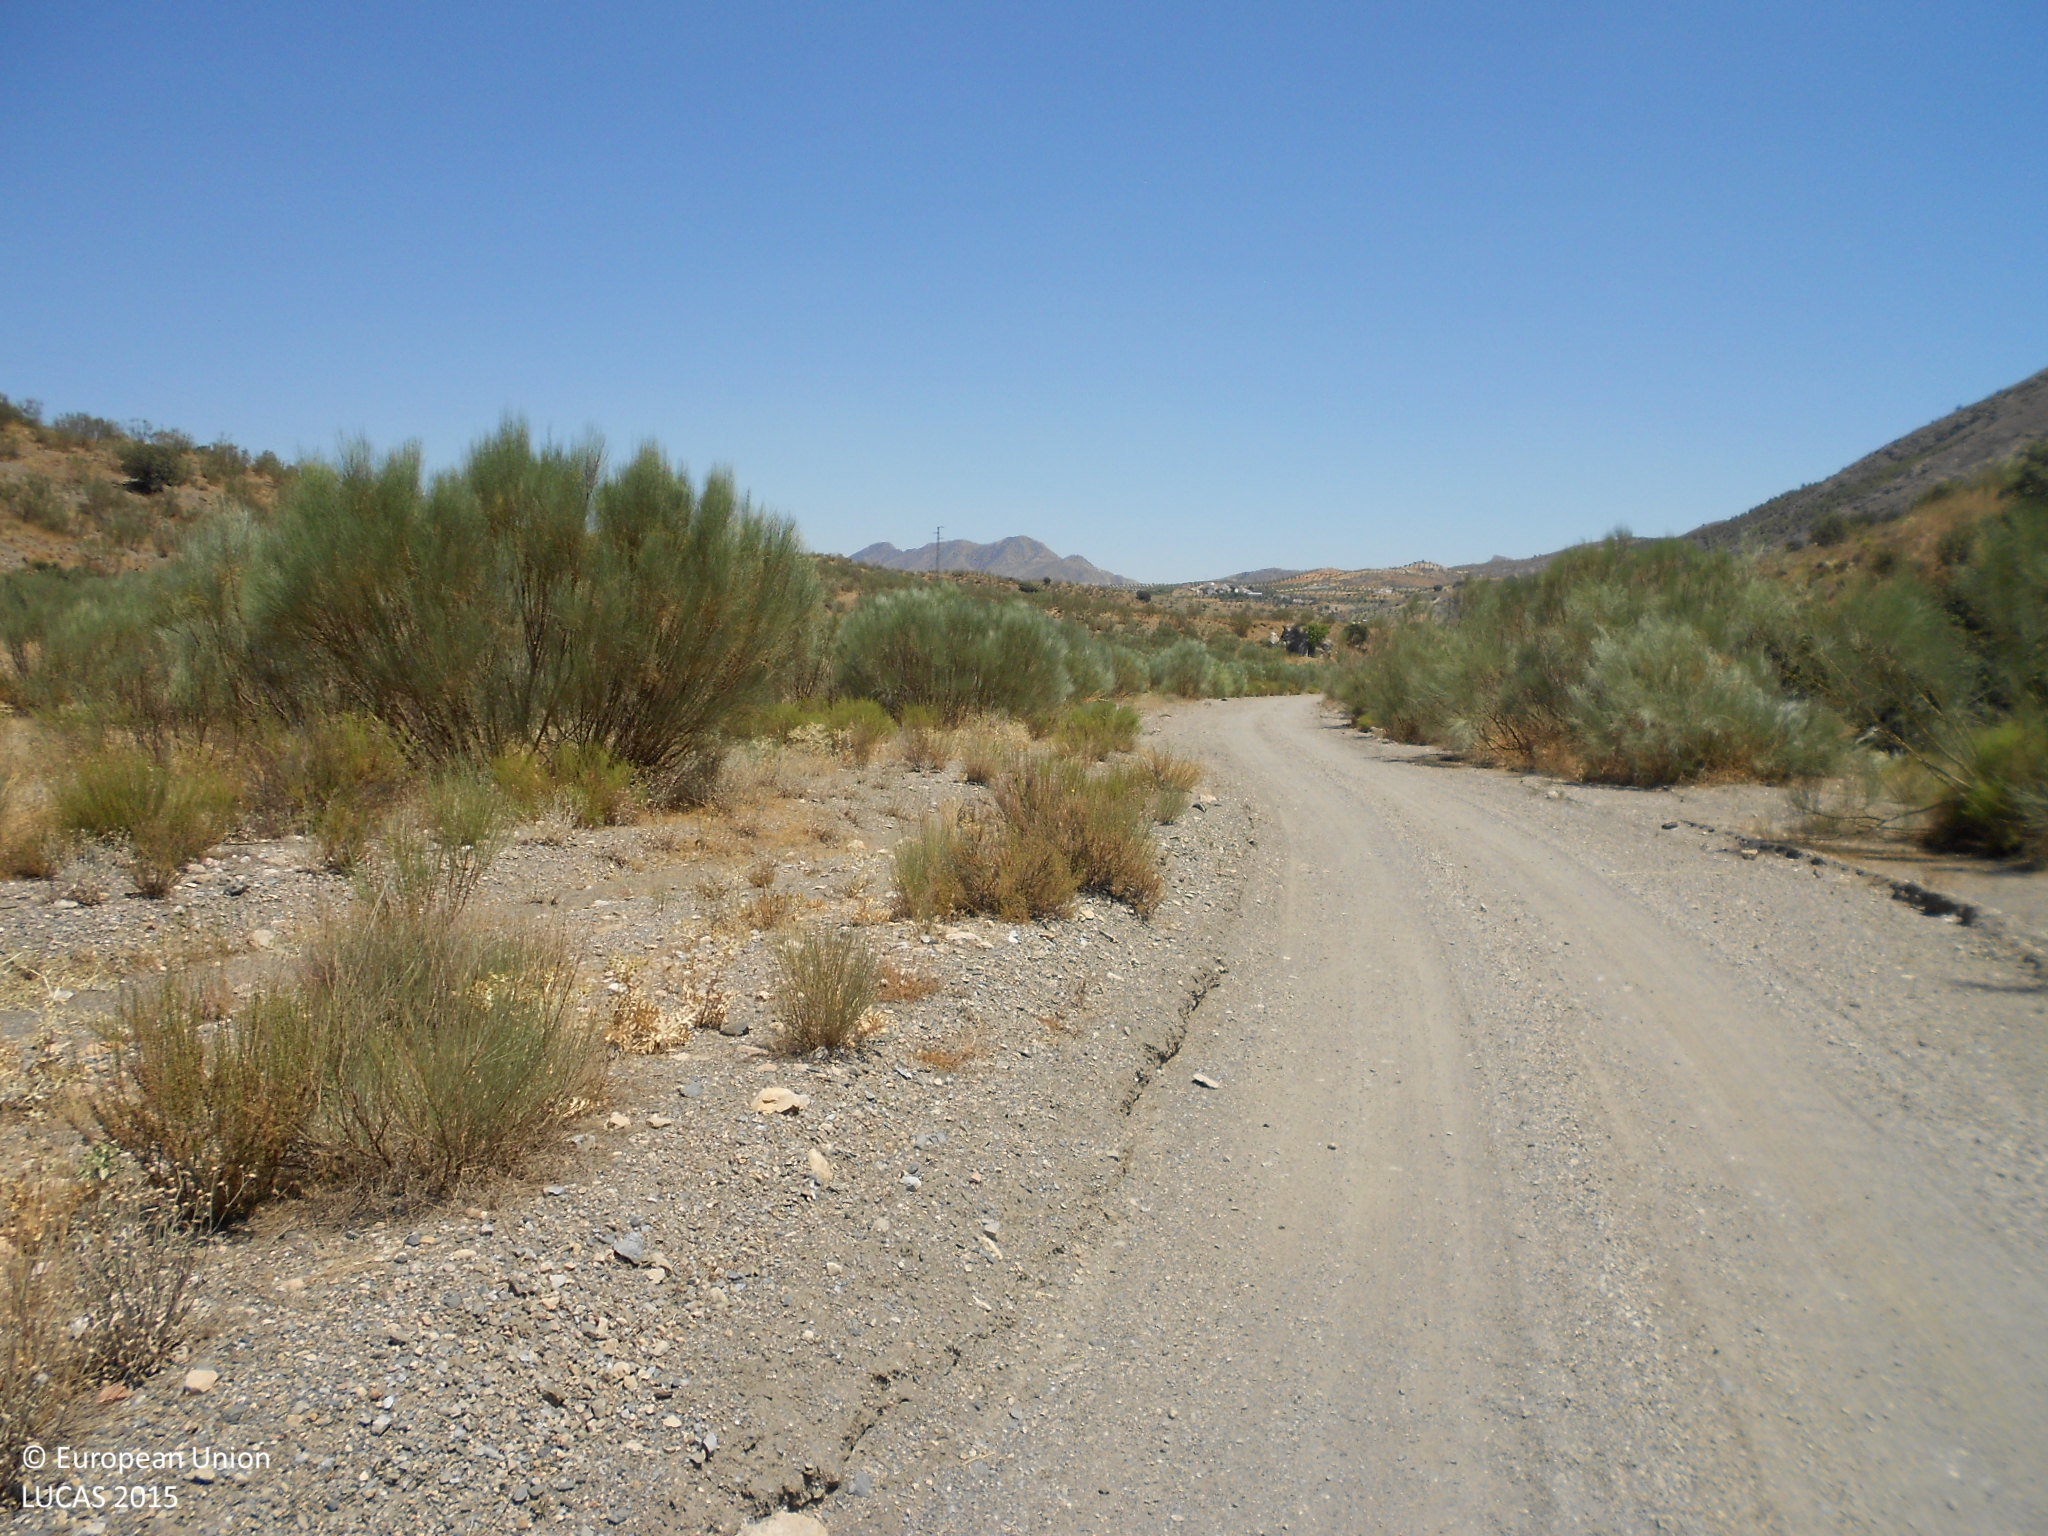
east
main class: Woodland
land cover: Broadleaved woodland
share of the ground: 25 - 50 %
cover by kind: consolidated bare surface 60 %, broadleaved forest trees 40 %
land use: Semi-natural and natural areas not in use
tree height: < 5 m
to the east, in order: Broadleaved woodland
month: July
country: ES
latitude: 37.5190
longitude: -2.2599
